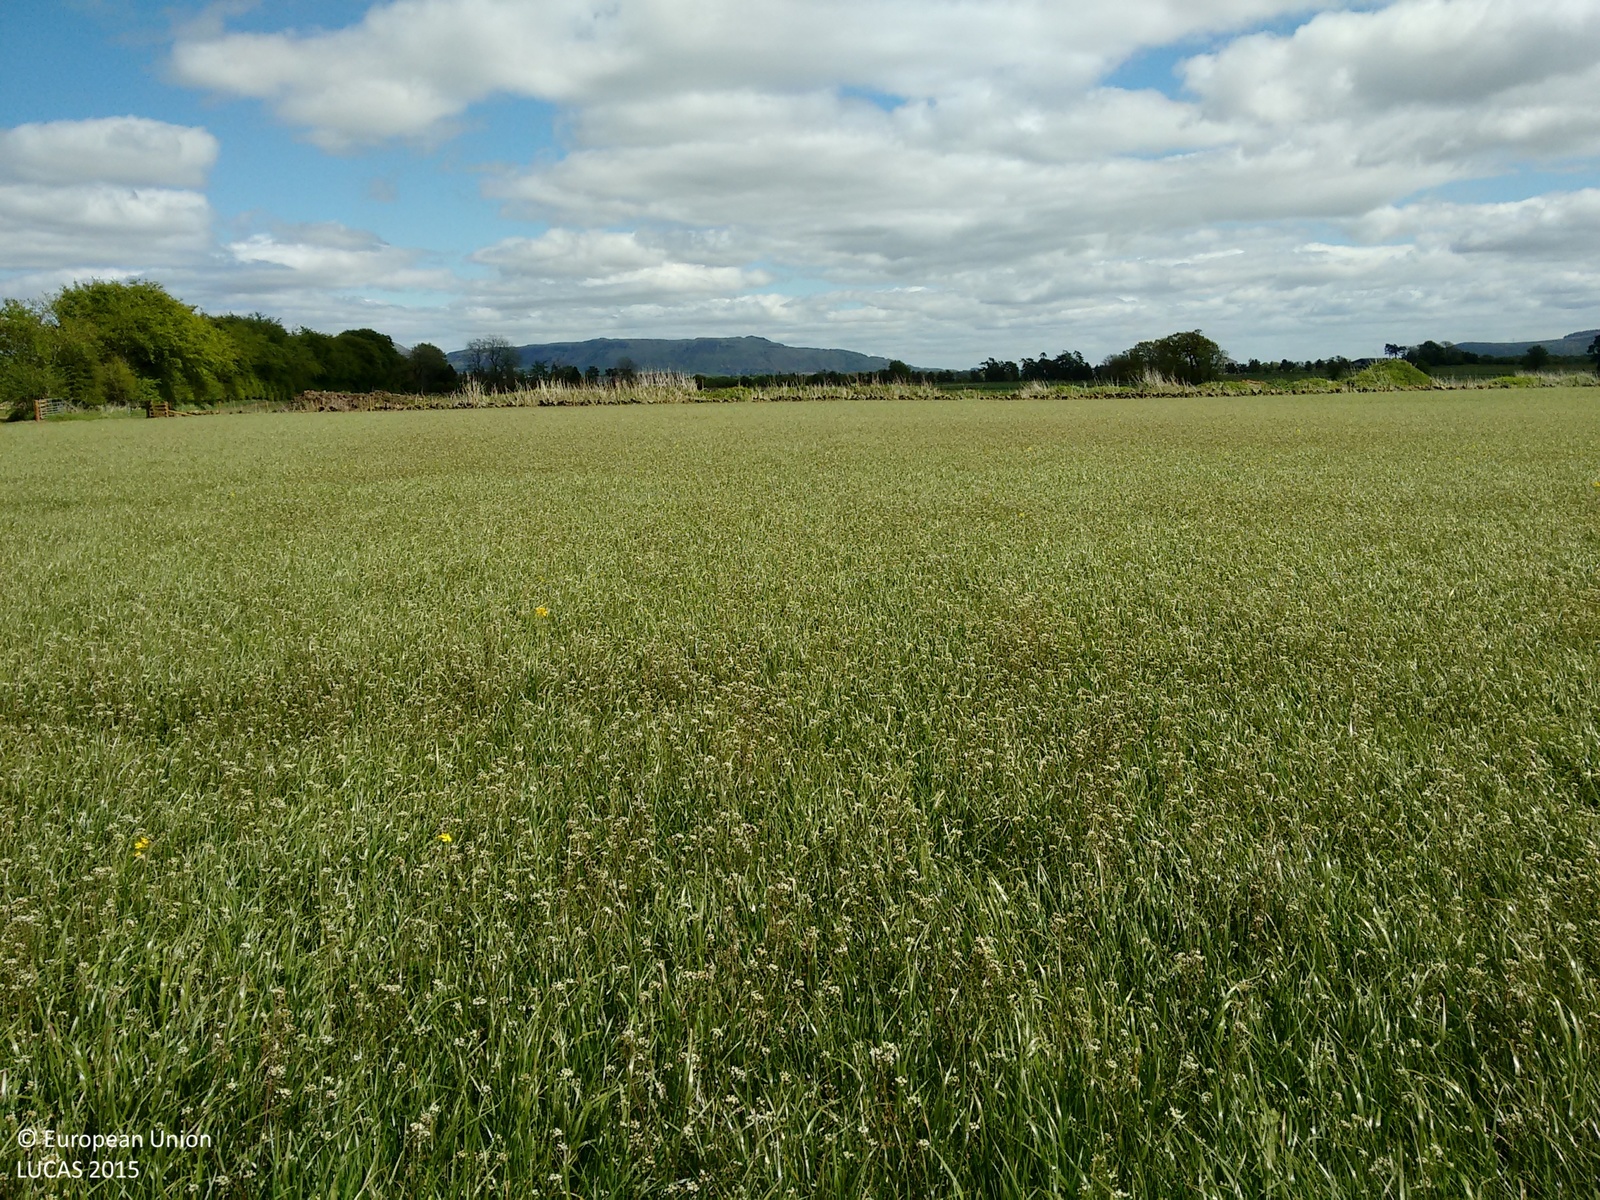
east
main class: Cropland
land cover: Mixed cereals for fodder
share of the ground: > 75 %
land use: Agriculture (excluding fallow land and kitchen gardens)
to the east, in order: Mixed cereals for fodder; Fences; Dry stone walls; Grassland without tree/shrub cover; Rye
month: May
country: GB
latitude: 56.2034
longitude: -3.4712
